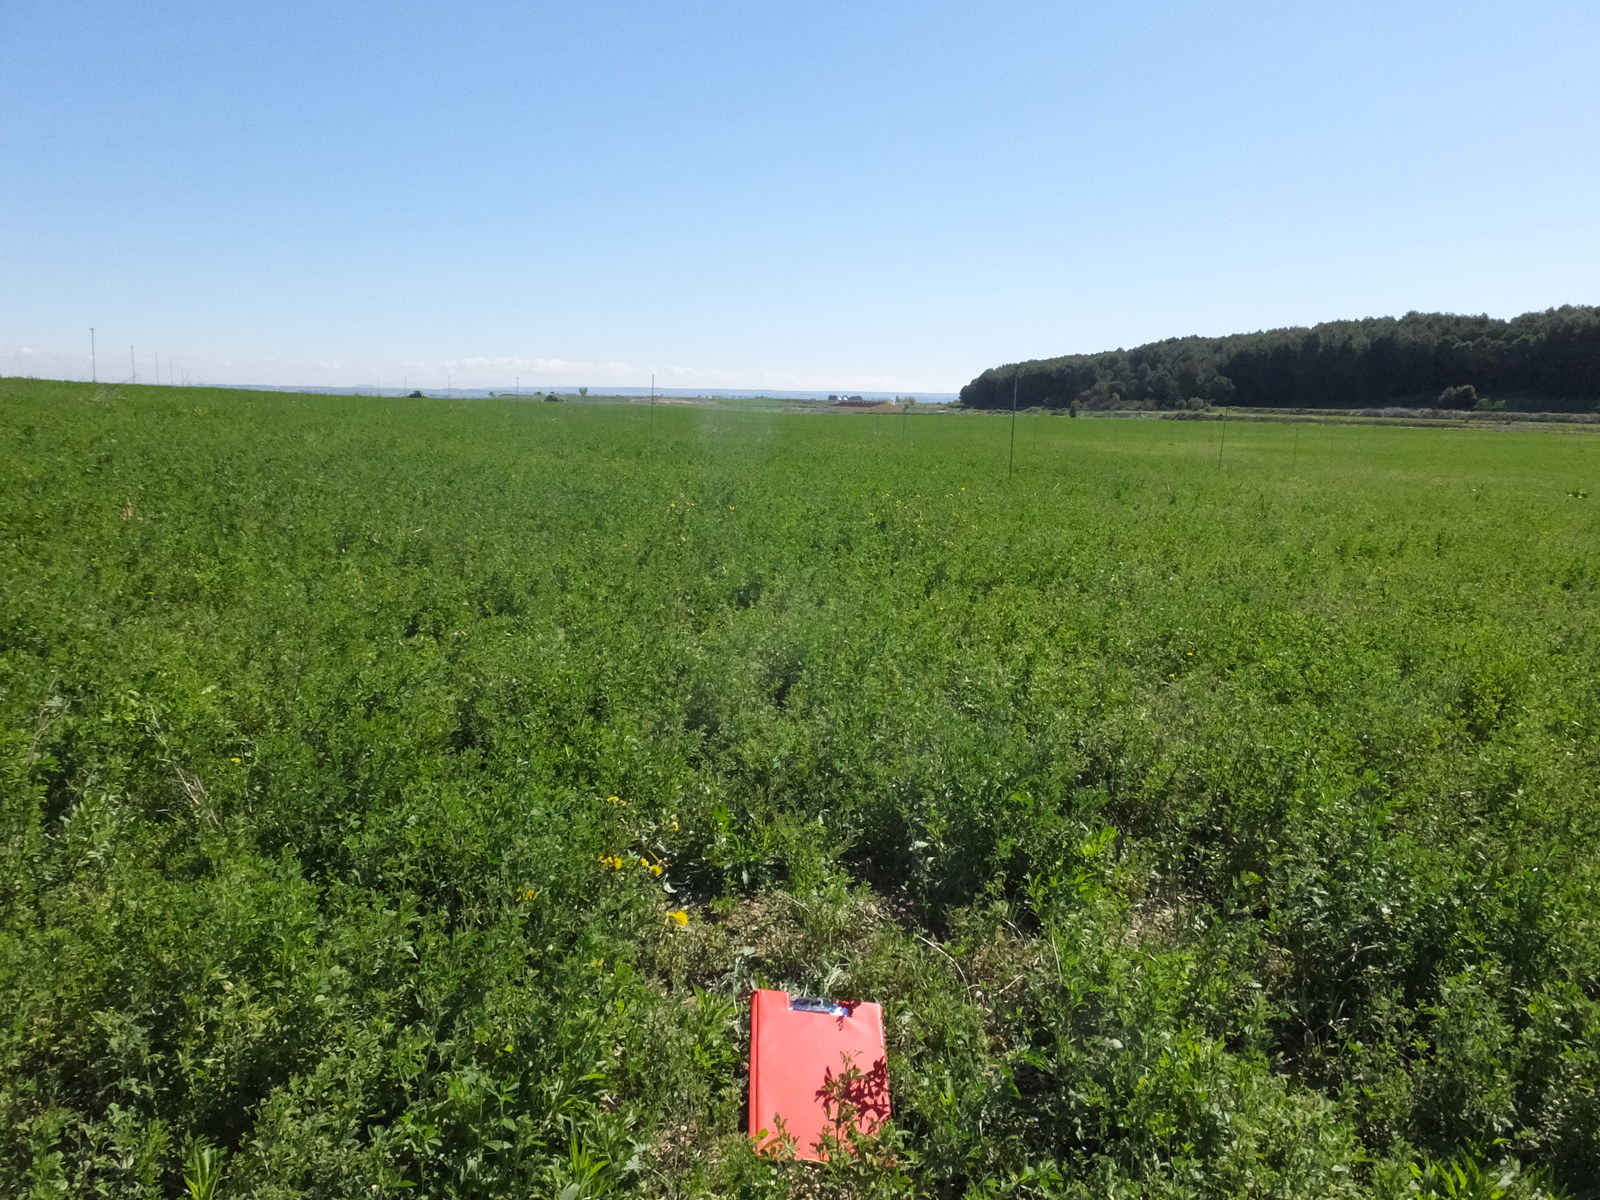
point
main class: Cropland
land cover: Lucerne
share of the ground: > 75 %
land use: Agriculture (excluding fallow land and kitchen gardens)
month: April
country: ES
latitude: 41.8195
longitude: -0.2882
